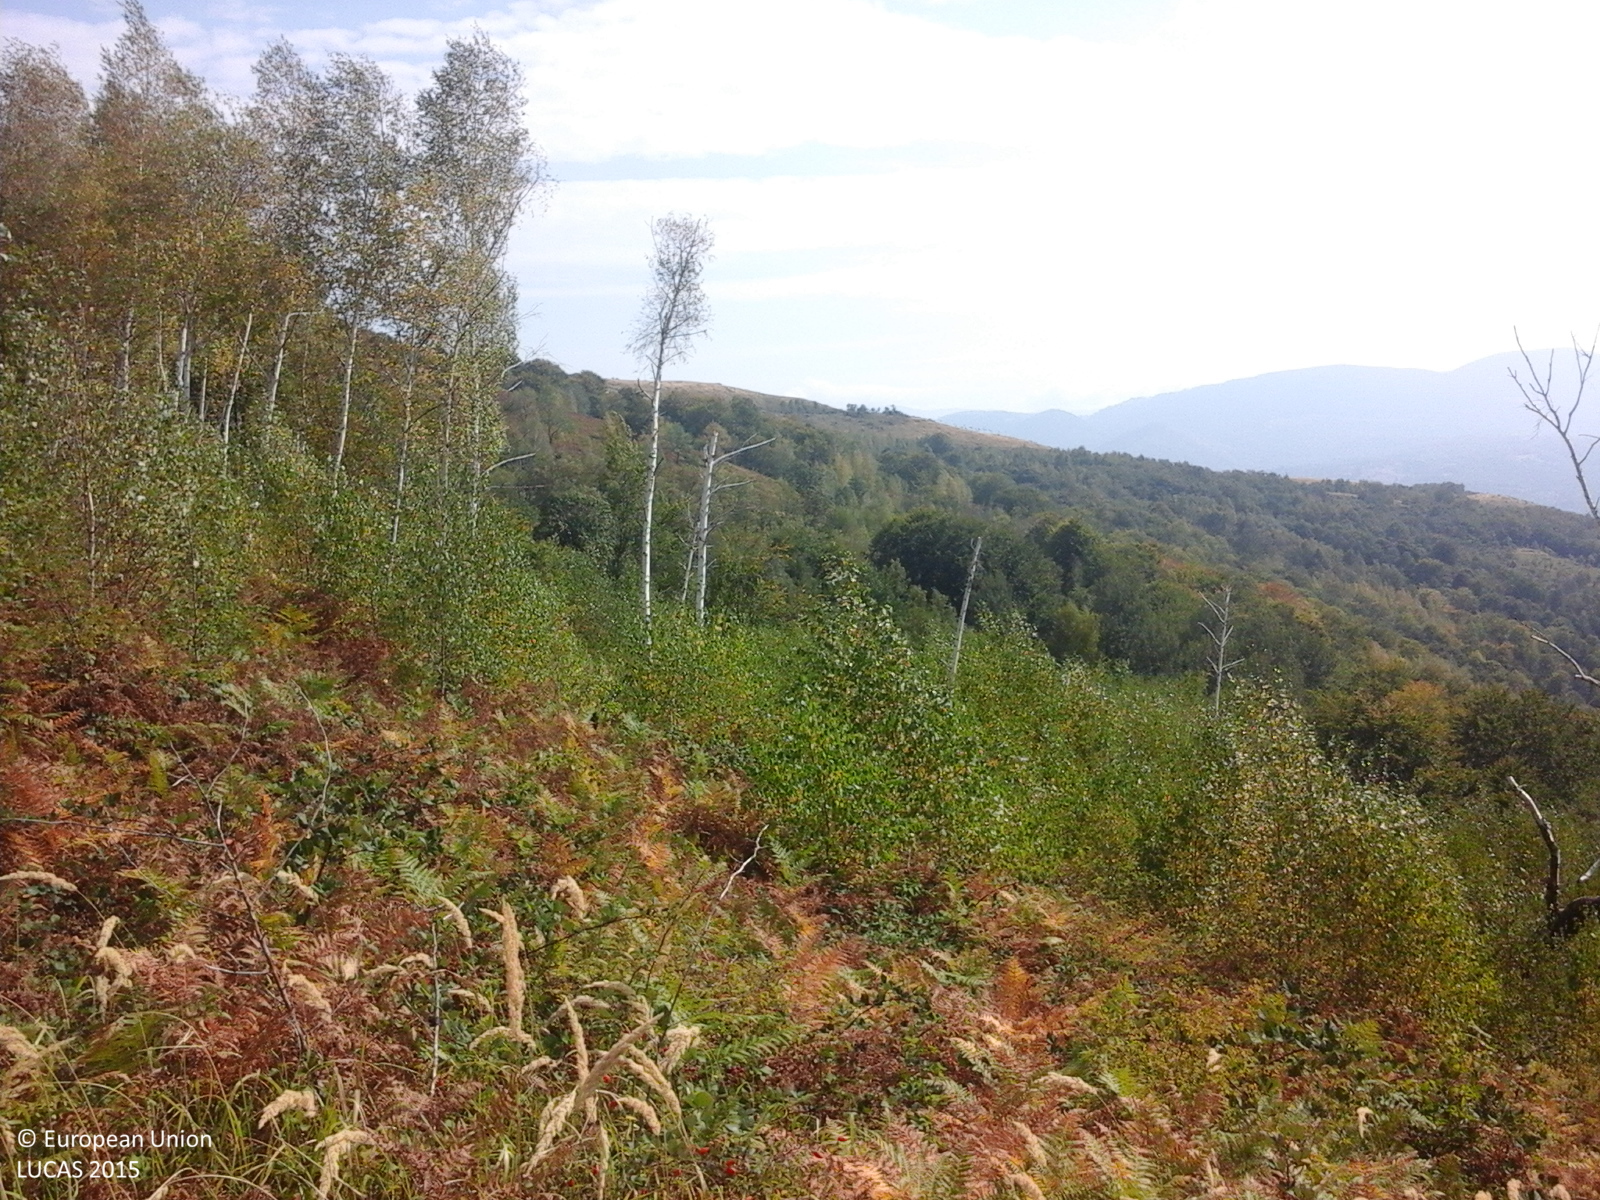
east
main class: Grassland
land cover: Spontaneously vegetated surfaces
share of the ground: > 75 %
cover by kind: herbaceous plants 100 %
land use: Fallow land
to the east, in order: Spontaneously vegetated surfaces; Broadleaved woodland; Other fruit trees and berries; Broadleaved woodland
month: September
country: RO
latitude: 45.1686
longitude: 22.2669
